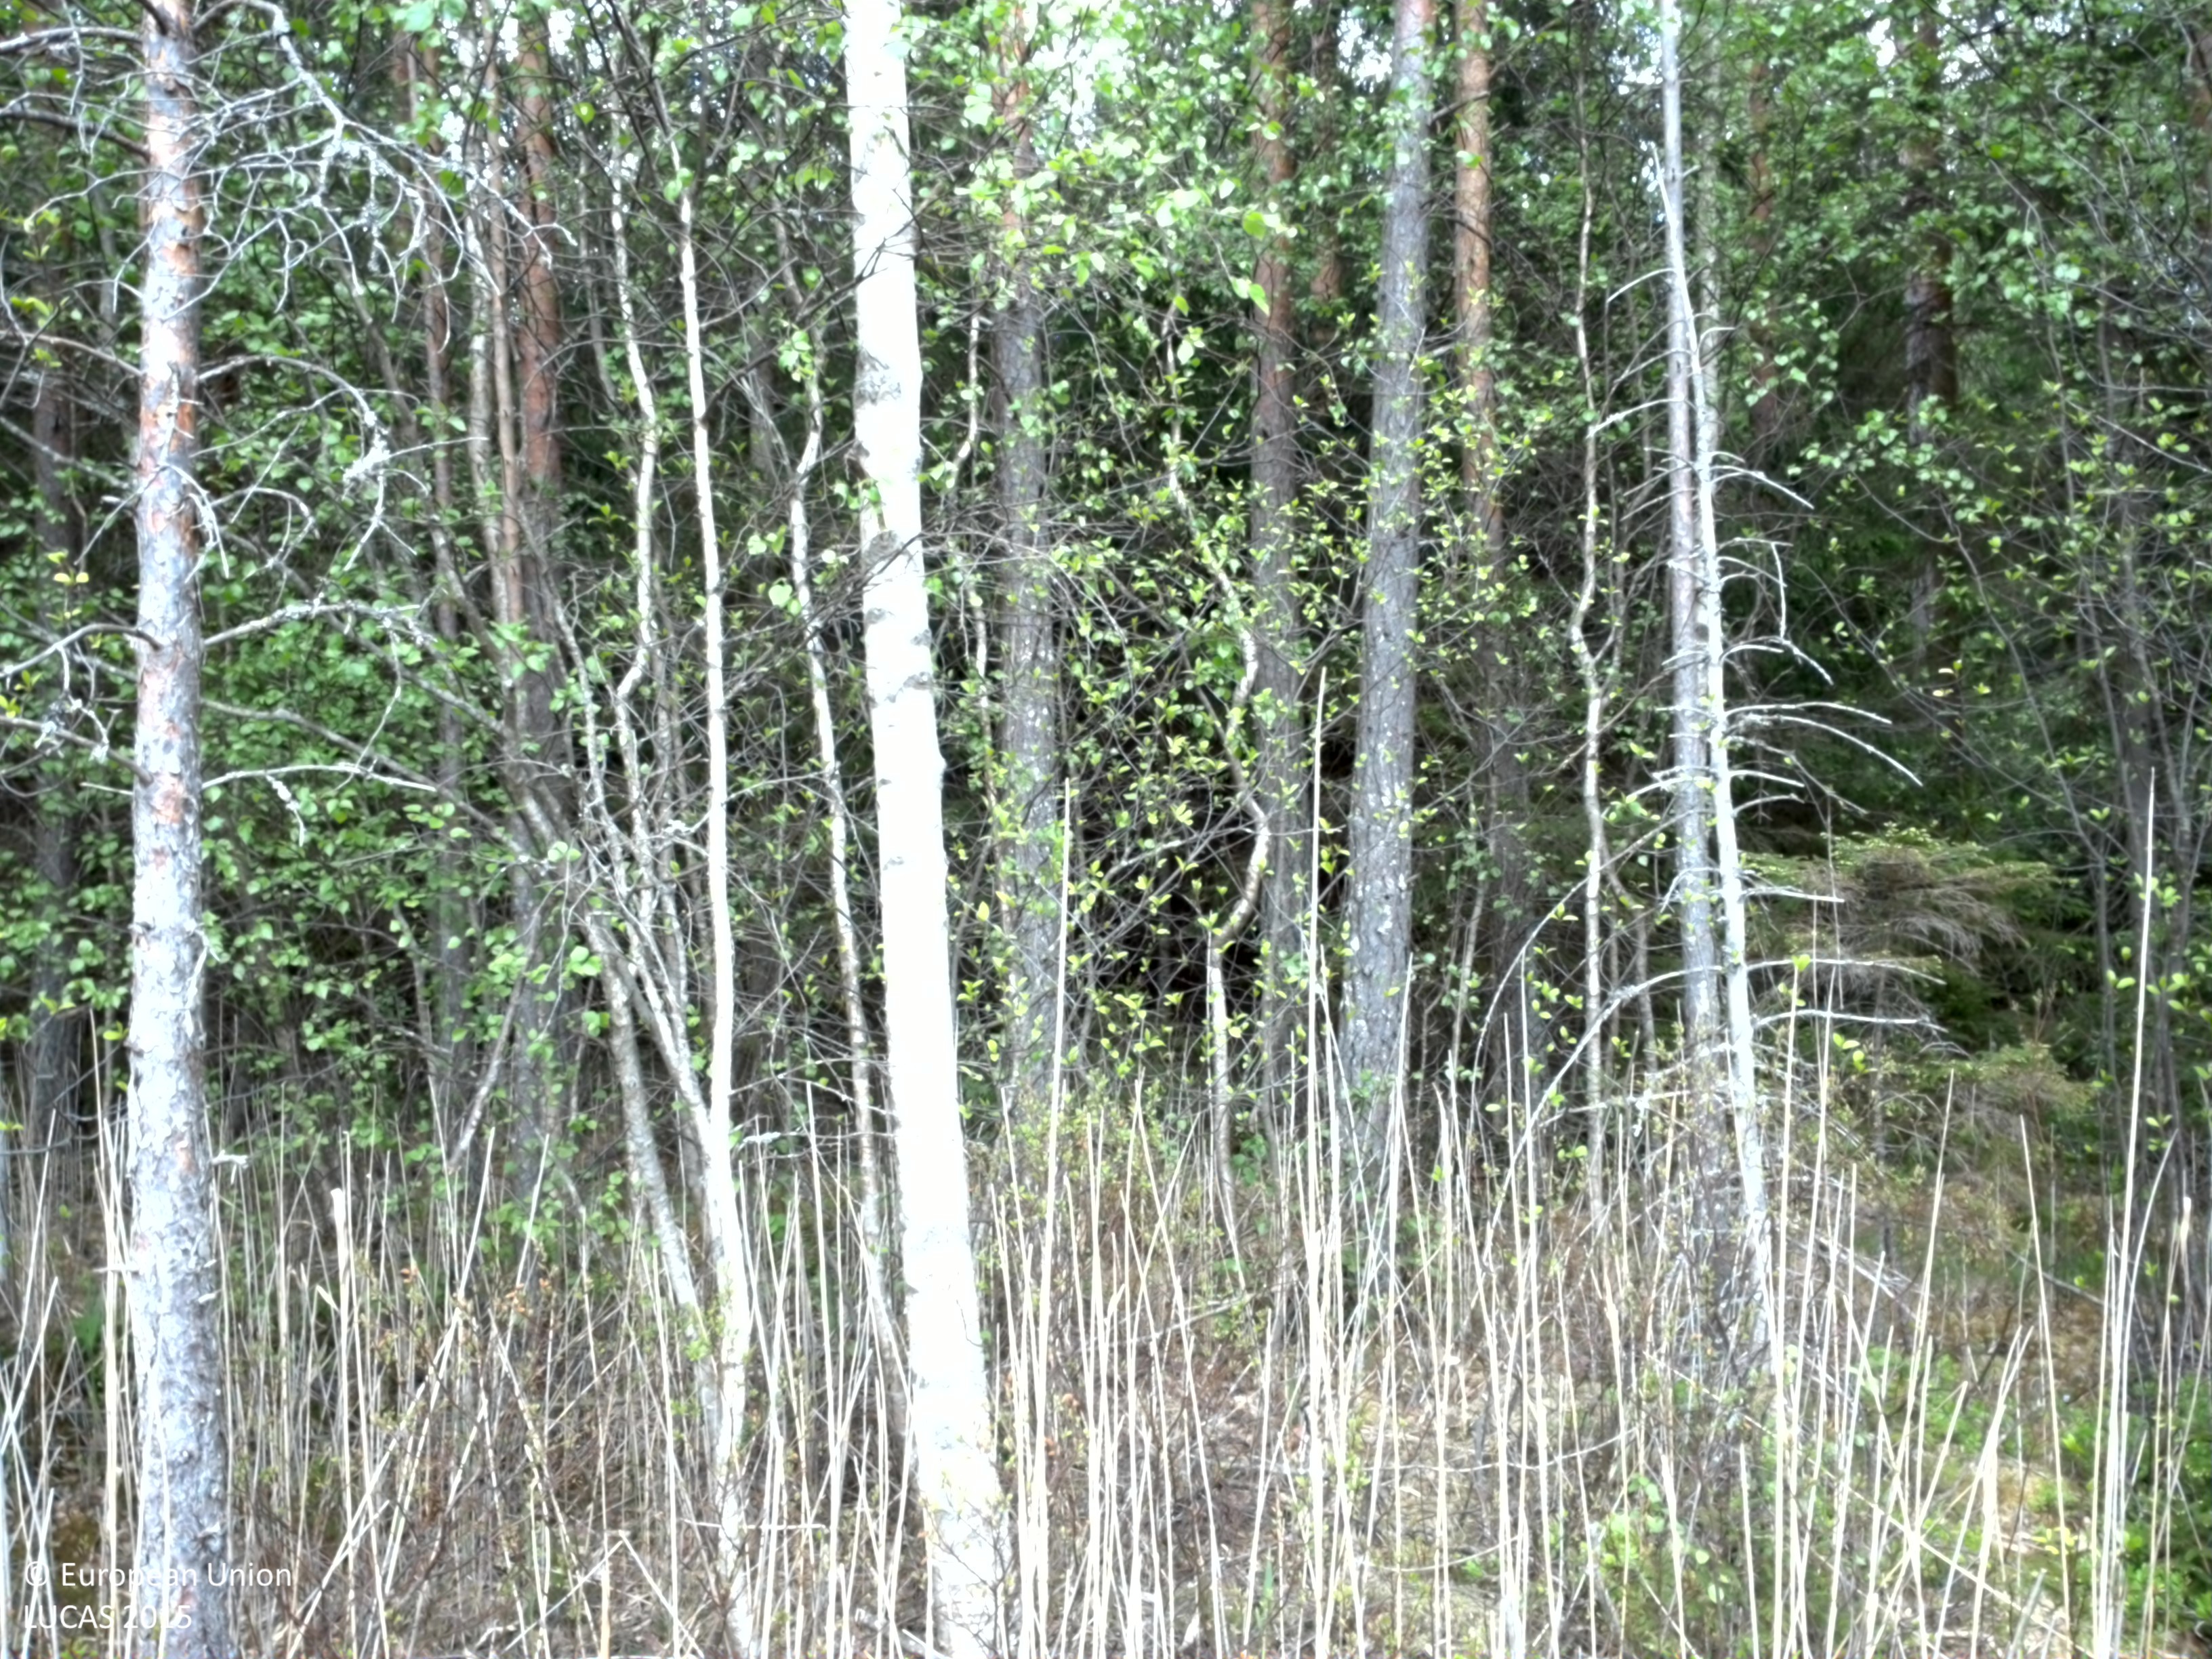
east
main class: Shrubland
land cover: Shrubland with sparse tree cover
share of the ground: 25 - 50 %
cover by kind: lichens and mosses 60 %, shrubs 25 %, herbaceous plants 10 %, broadleaved forest trees 5 %
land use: Semi-natural and natural areas not in use
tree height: < 5 m
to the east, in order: Shrubland with sparse tree cover; Broadleaved woodland; Pine dominated mixed woodland; Spruce dominated coniferous woodland; Ditches and canals; Grass margins; Paved roads, cycling and walking lanes; Grass margins; Broadleaved woodland; Spruce dominated mixed woodland; Broadleaved woodland; Pine dominated mixed woodland; Inland fresh water bodies
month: May
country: SE
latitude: 57.4215
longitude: 15.5086
